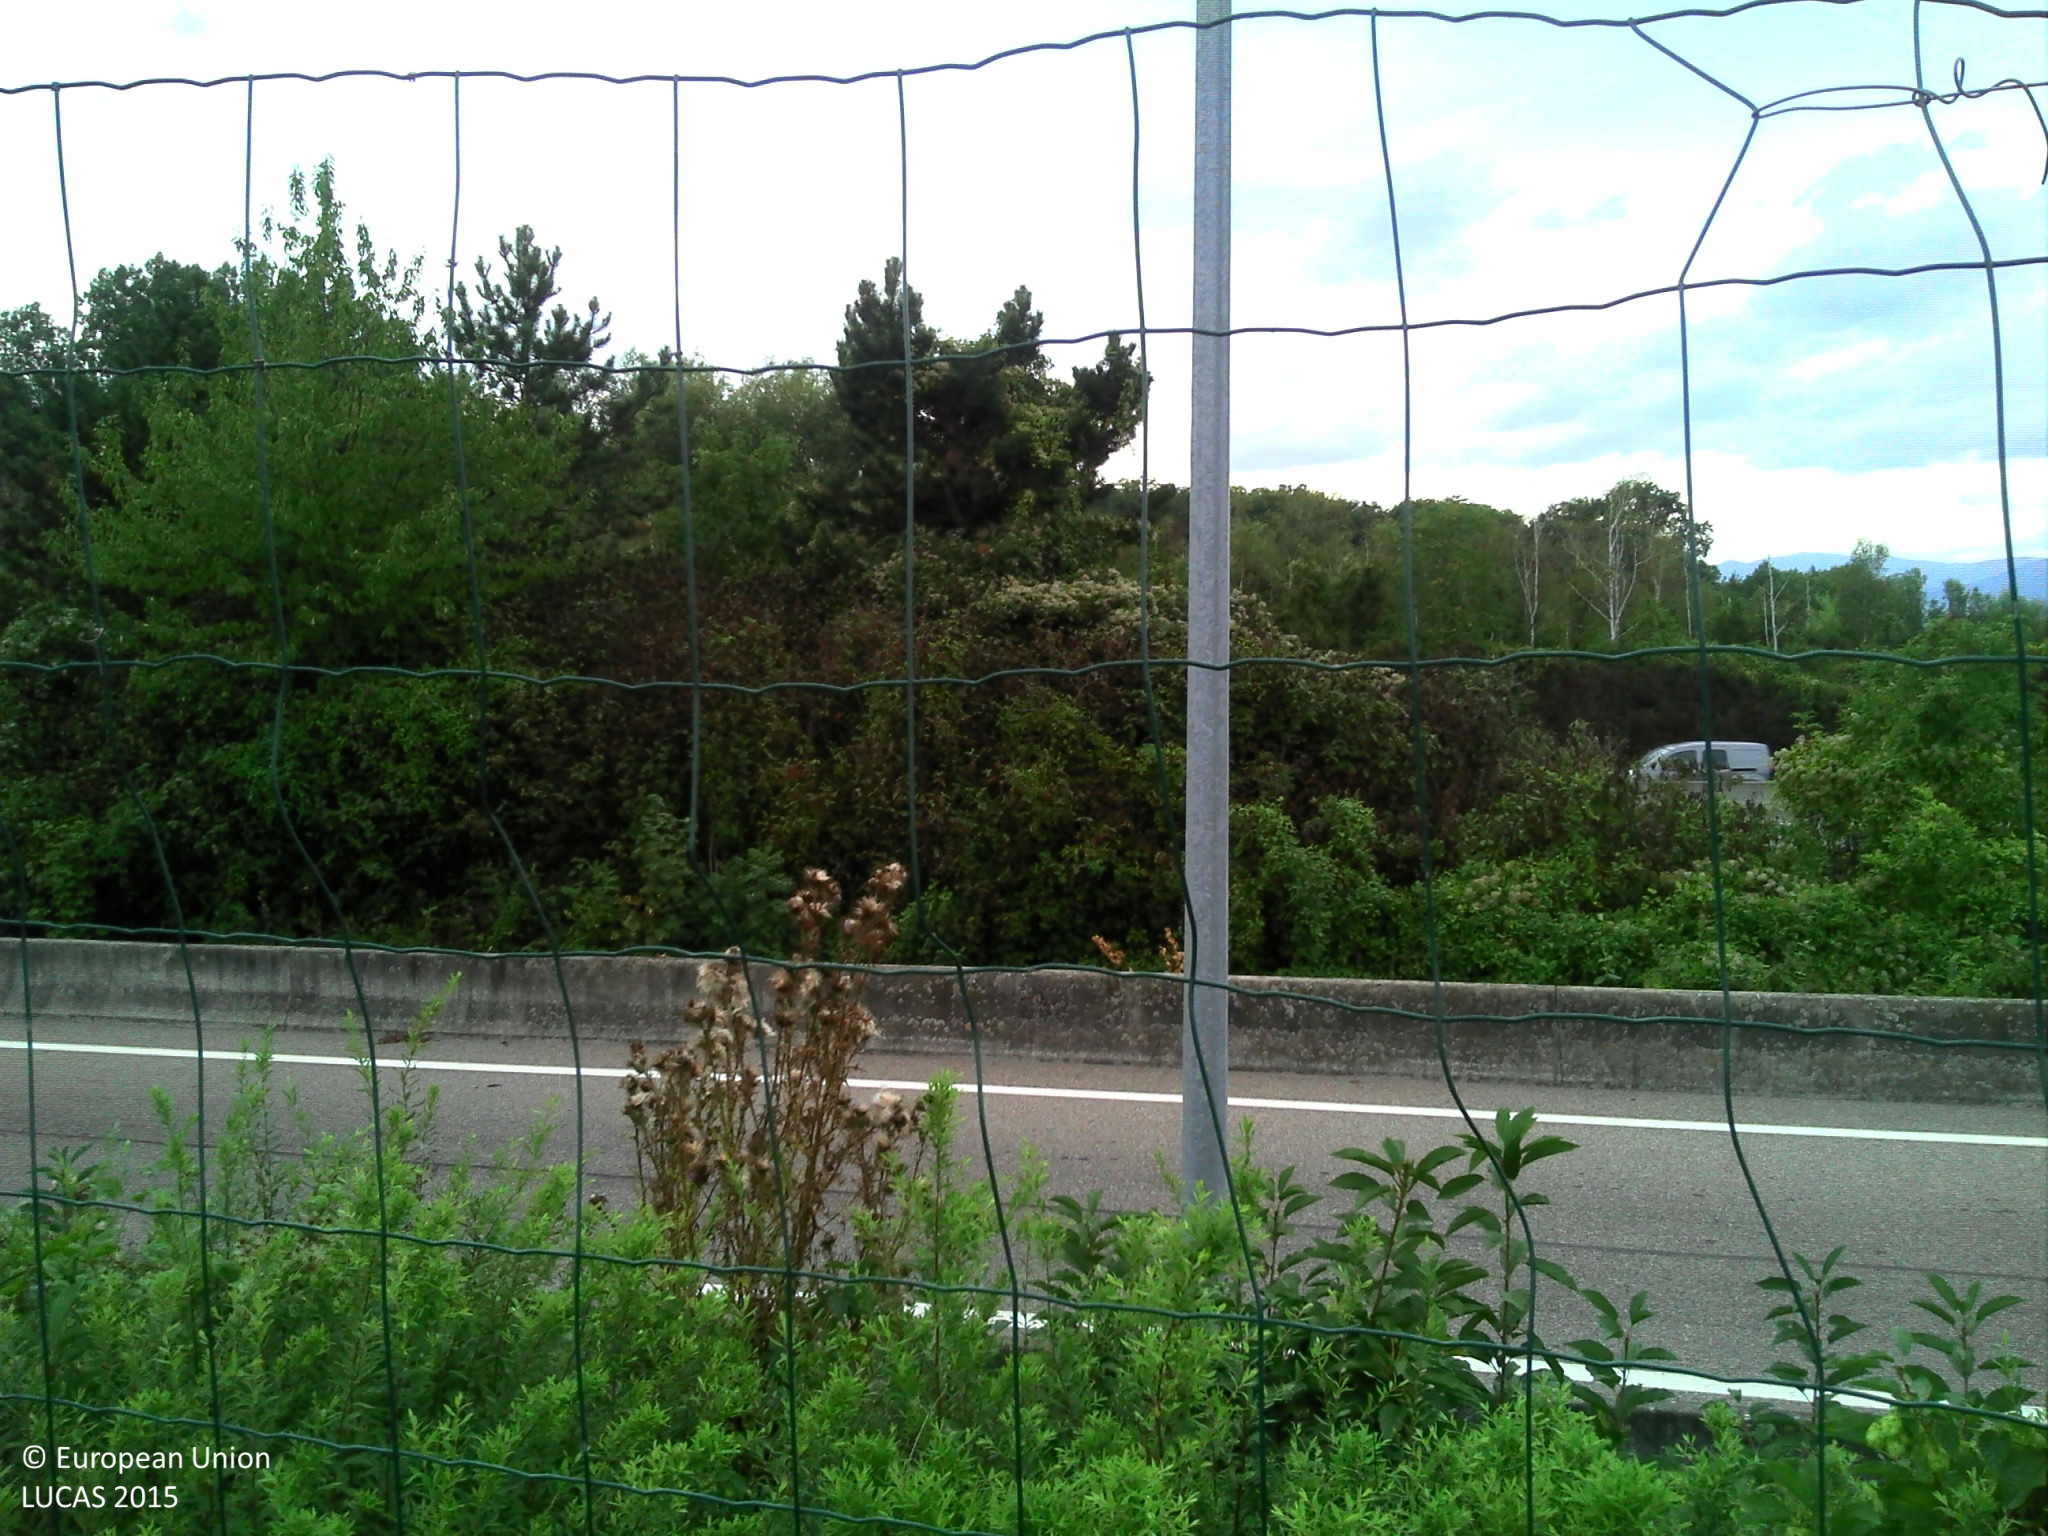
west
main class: Woodland
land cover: Broadleaved woodland
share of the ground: > 75 %
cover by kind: broadleaved forest trees 60 %, herbaceous plants 35 %, coniferous forest trees 5 %
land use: Semi-natural and natural areas not in use
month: August
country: FR
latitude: 48.0665
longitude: 7.3843
